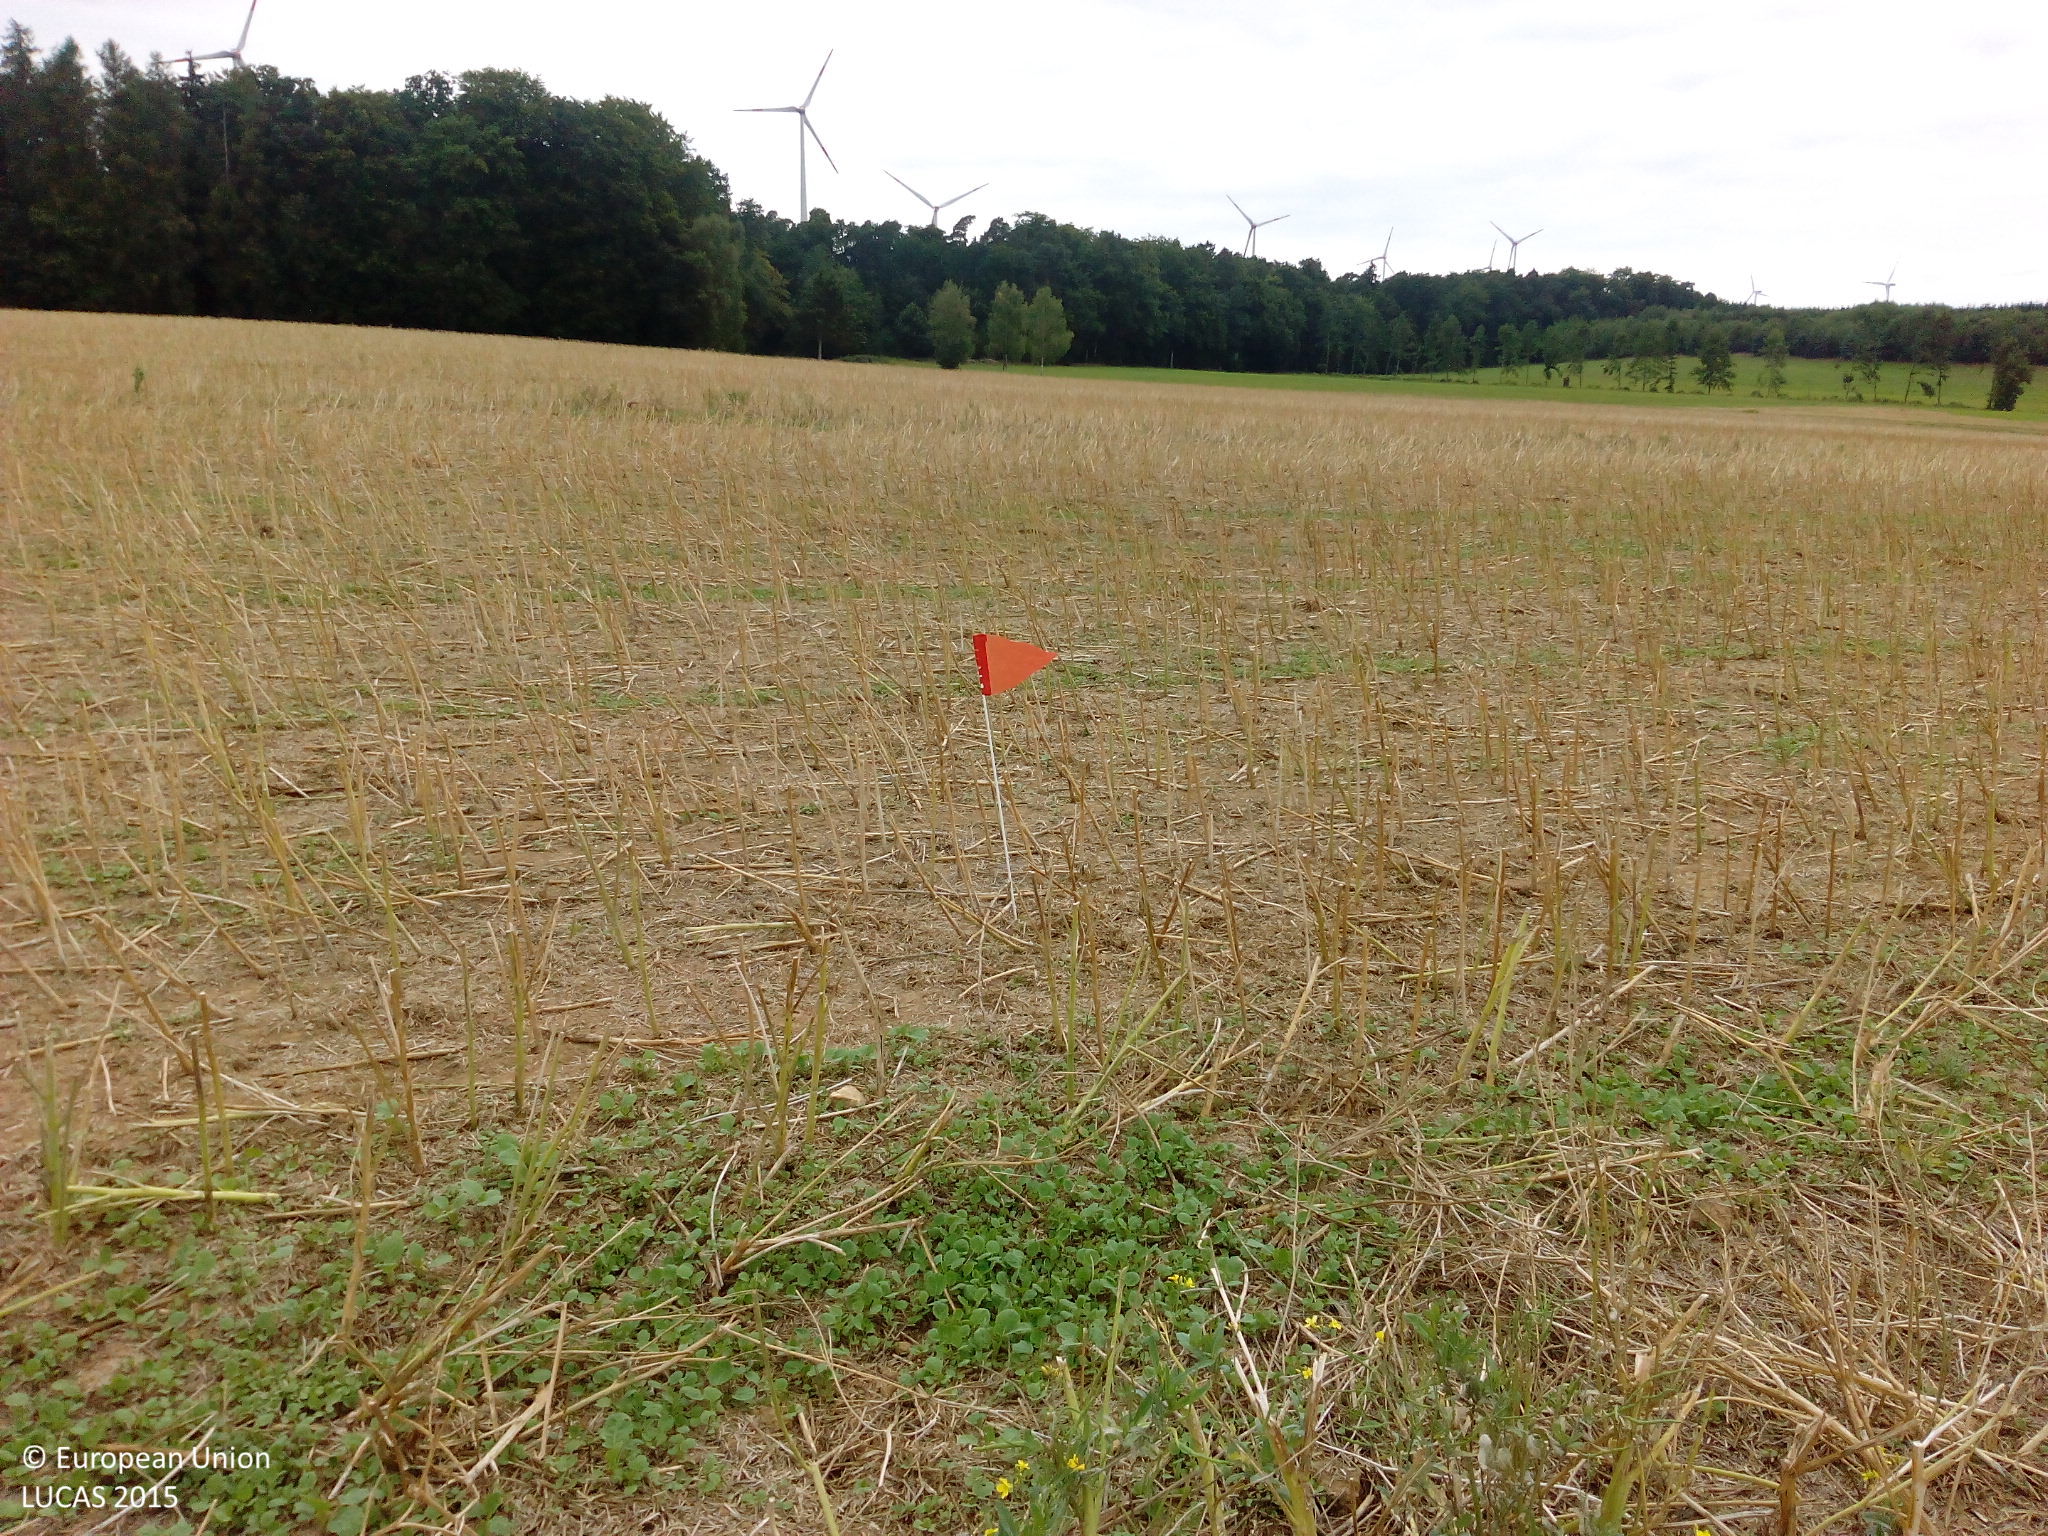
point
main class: Cropland
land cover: Rape and turnip rape
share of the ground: < 10 %
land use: Agriculture (excluding fallow land and kitchen gardens)
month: August
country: DE
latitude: 50.0136
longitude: 7.5303
